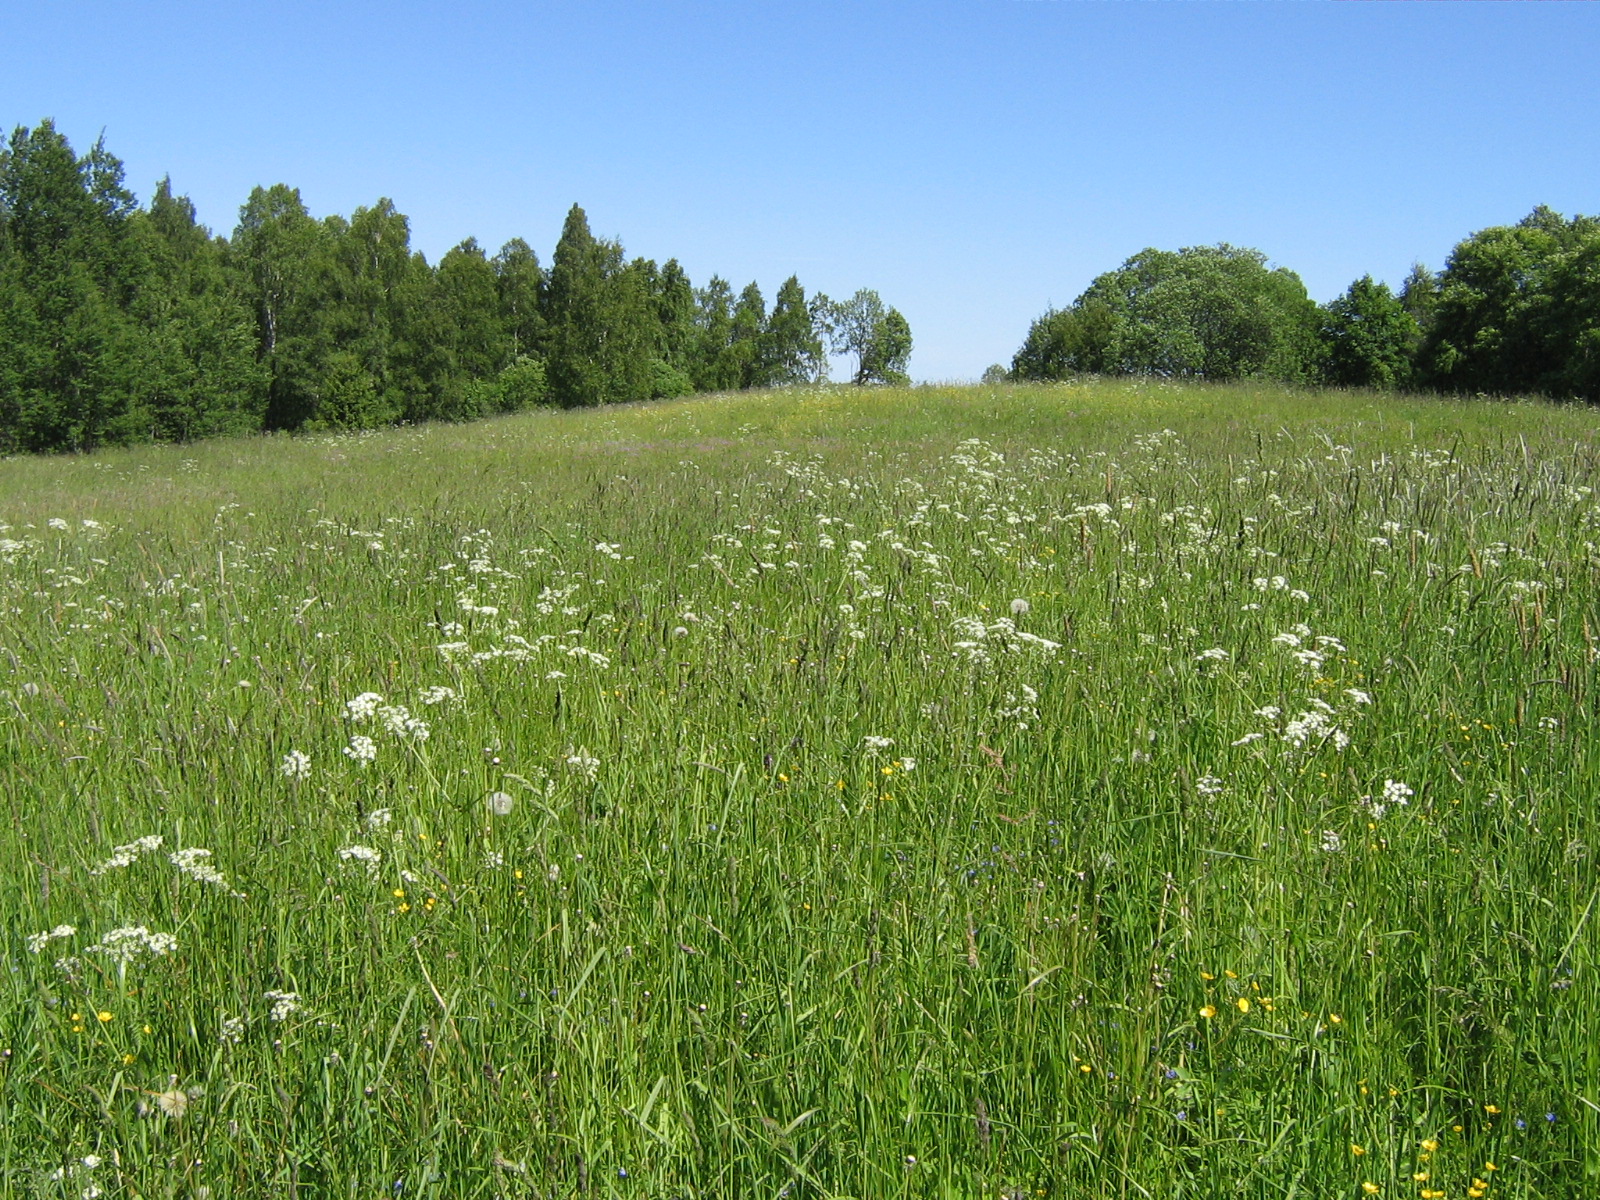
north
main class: Grassland
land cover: Grassland without tree/shrub cover
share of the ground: > 75 %
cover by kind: herbaceous plants 100 %
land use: Agriculture (excluding fallow land and kitchen gardens)
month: June
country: LV
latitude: 57.1206
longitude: 25.8667
